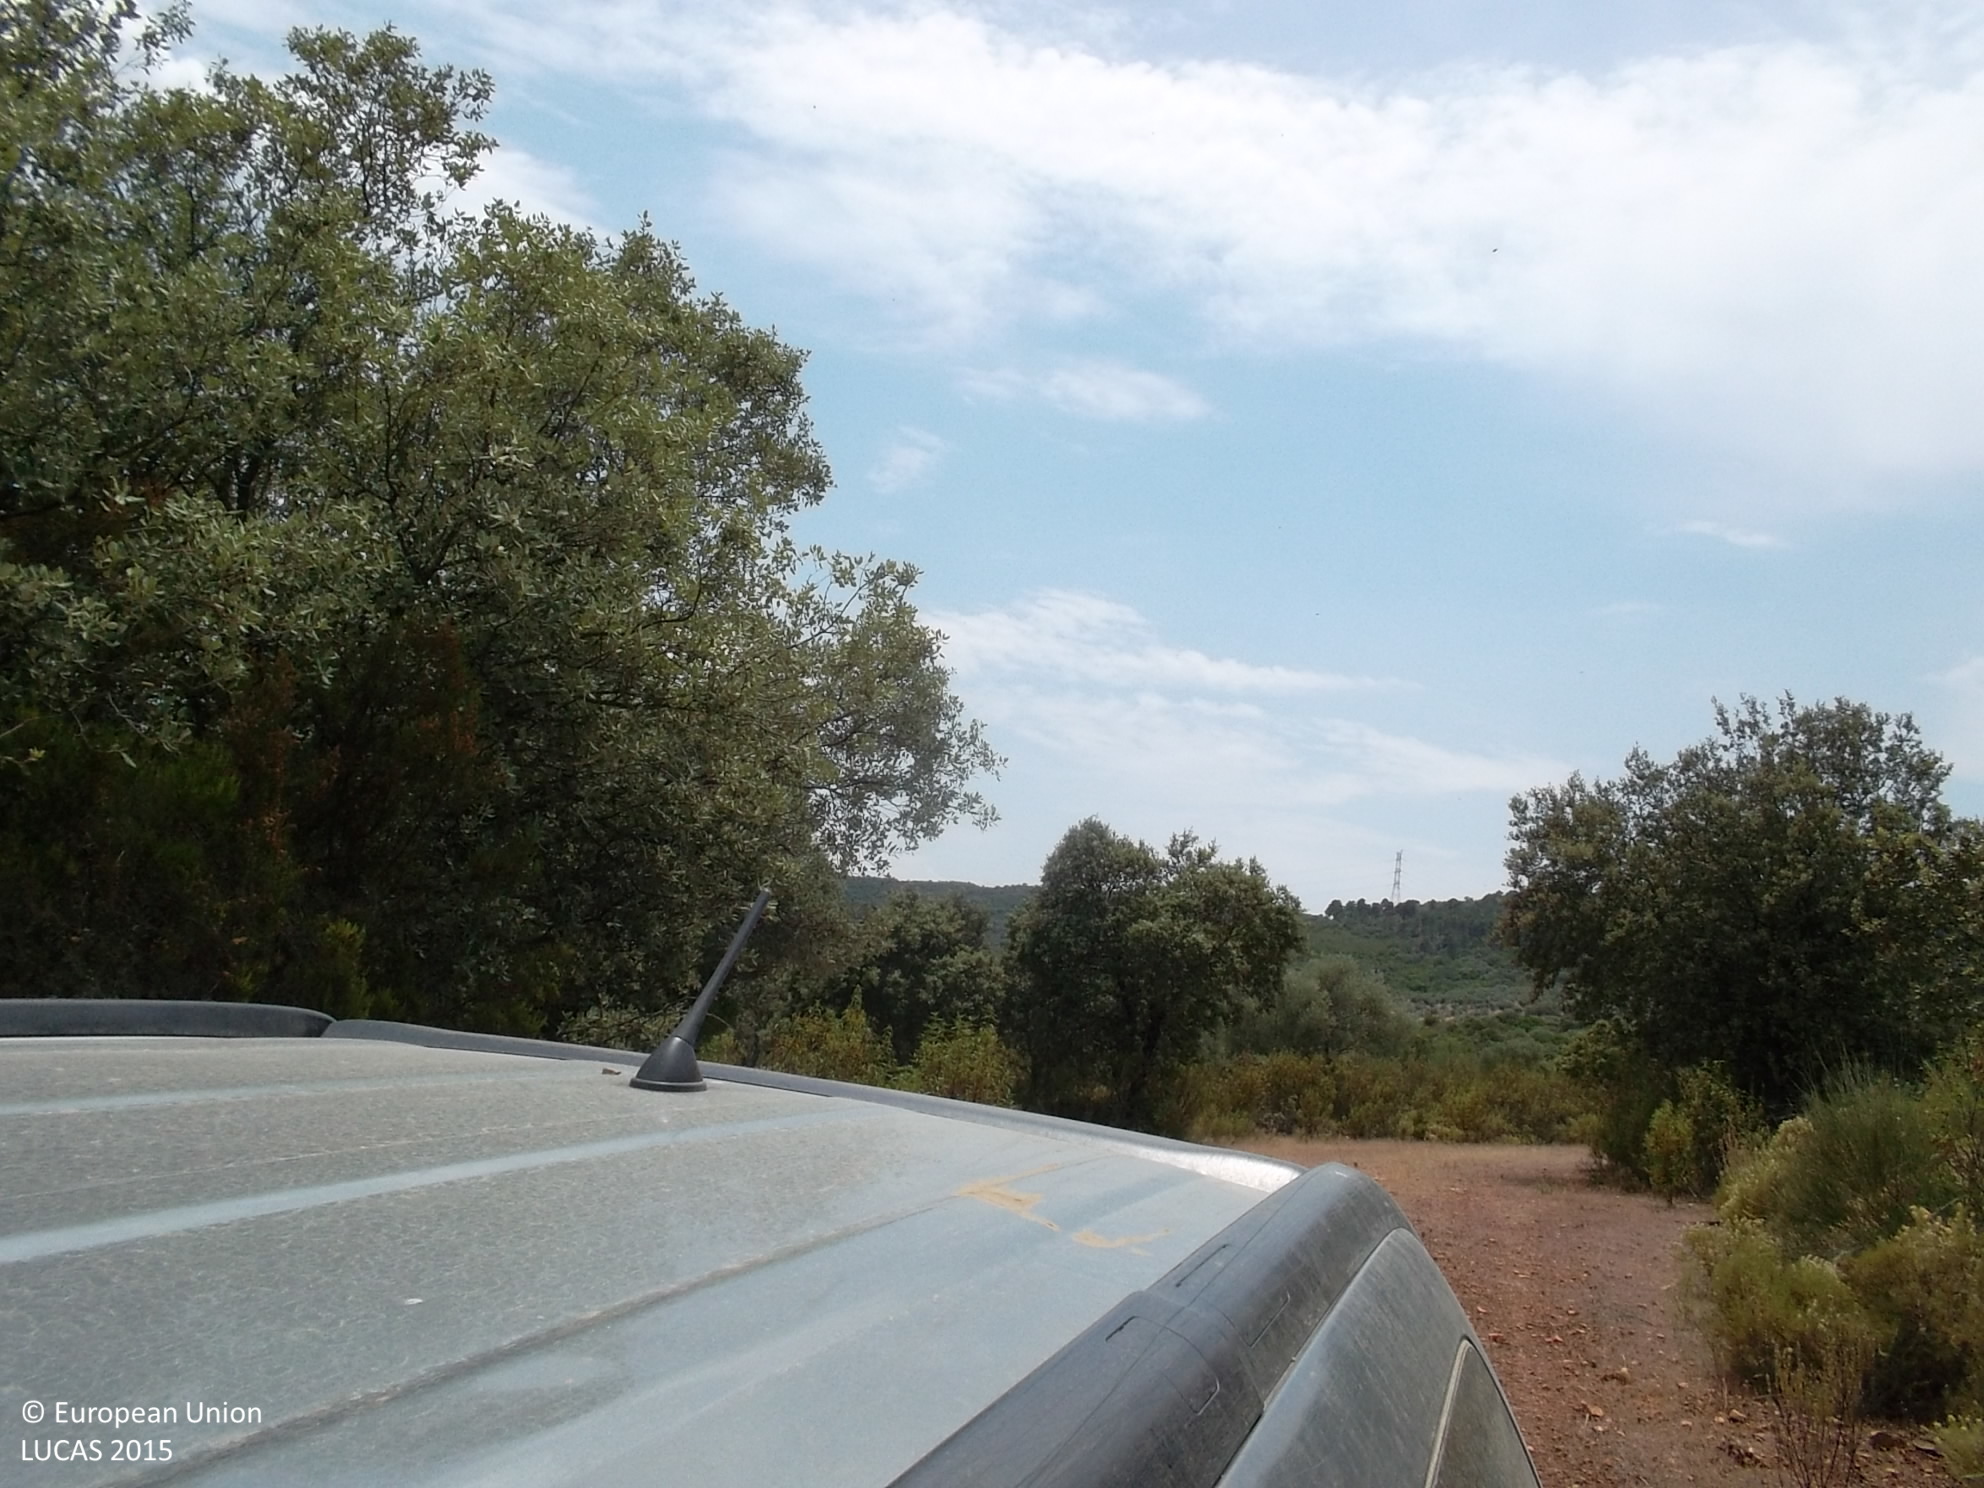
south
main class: Woodland
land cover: Broadleaved woodland
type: broadleaved evergreen forest
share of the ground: 50 - 75 %
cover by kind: shrubs 60 %, broadleaved forest trees 40 %
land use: Forestry
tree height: > 5 m
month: June
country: ES
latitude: 39.1757
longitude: -4.9114
